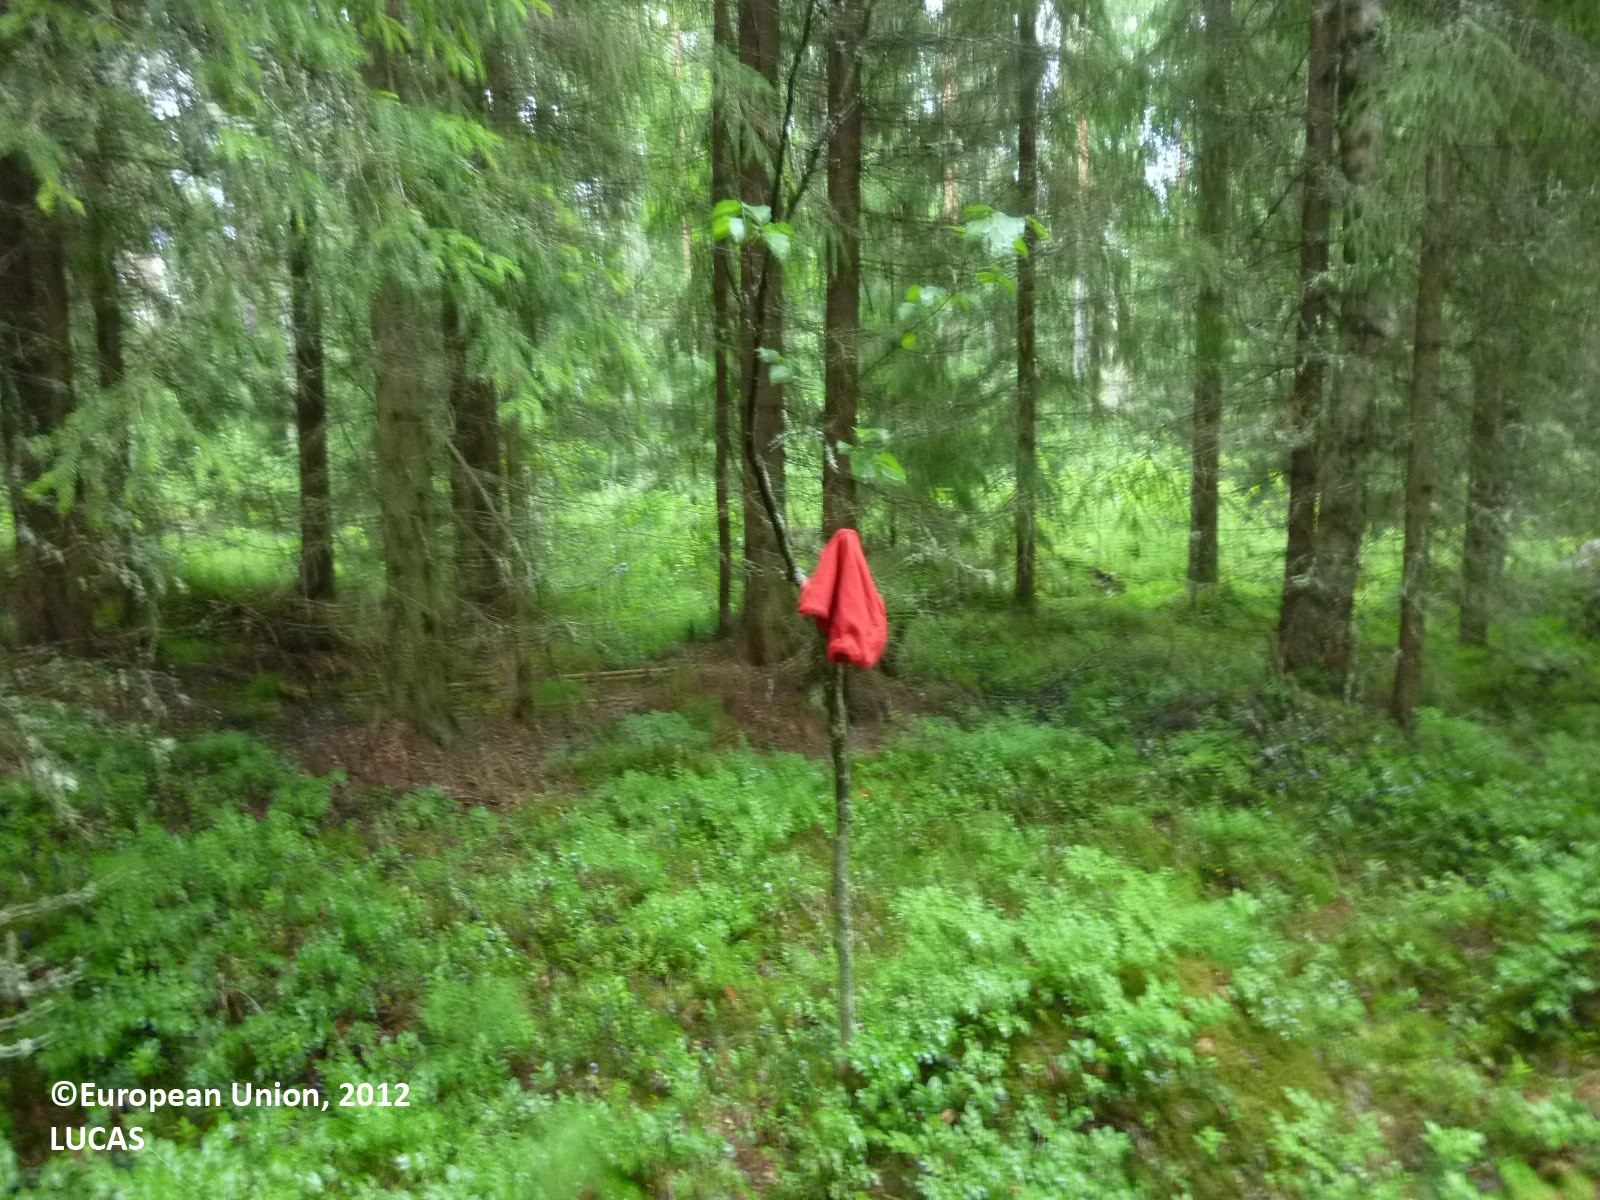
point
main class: Woodland
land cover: Spruce dominated coniferous woodland
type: boreal forest
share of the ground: > 75 %
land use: Forestry
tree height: > 5 m
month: July
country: FI
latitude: 61.4502
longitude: 22.2712
